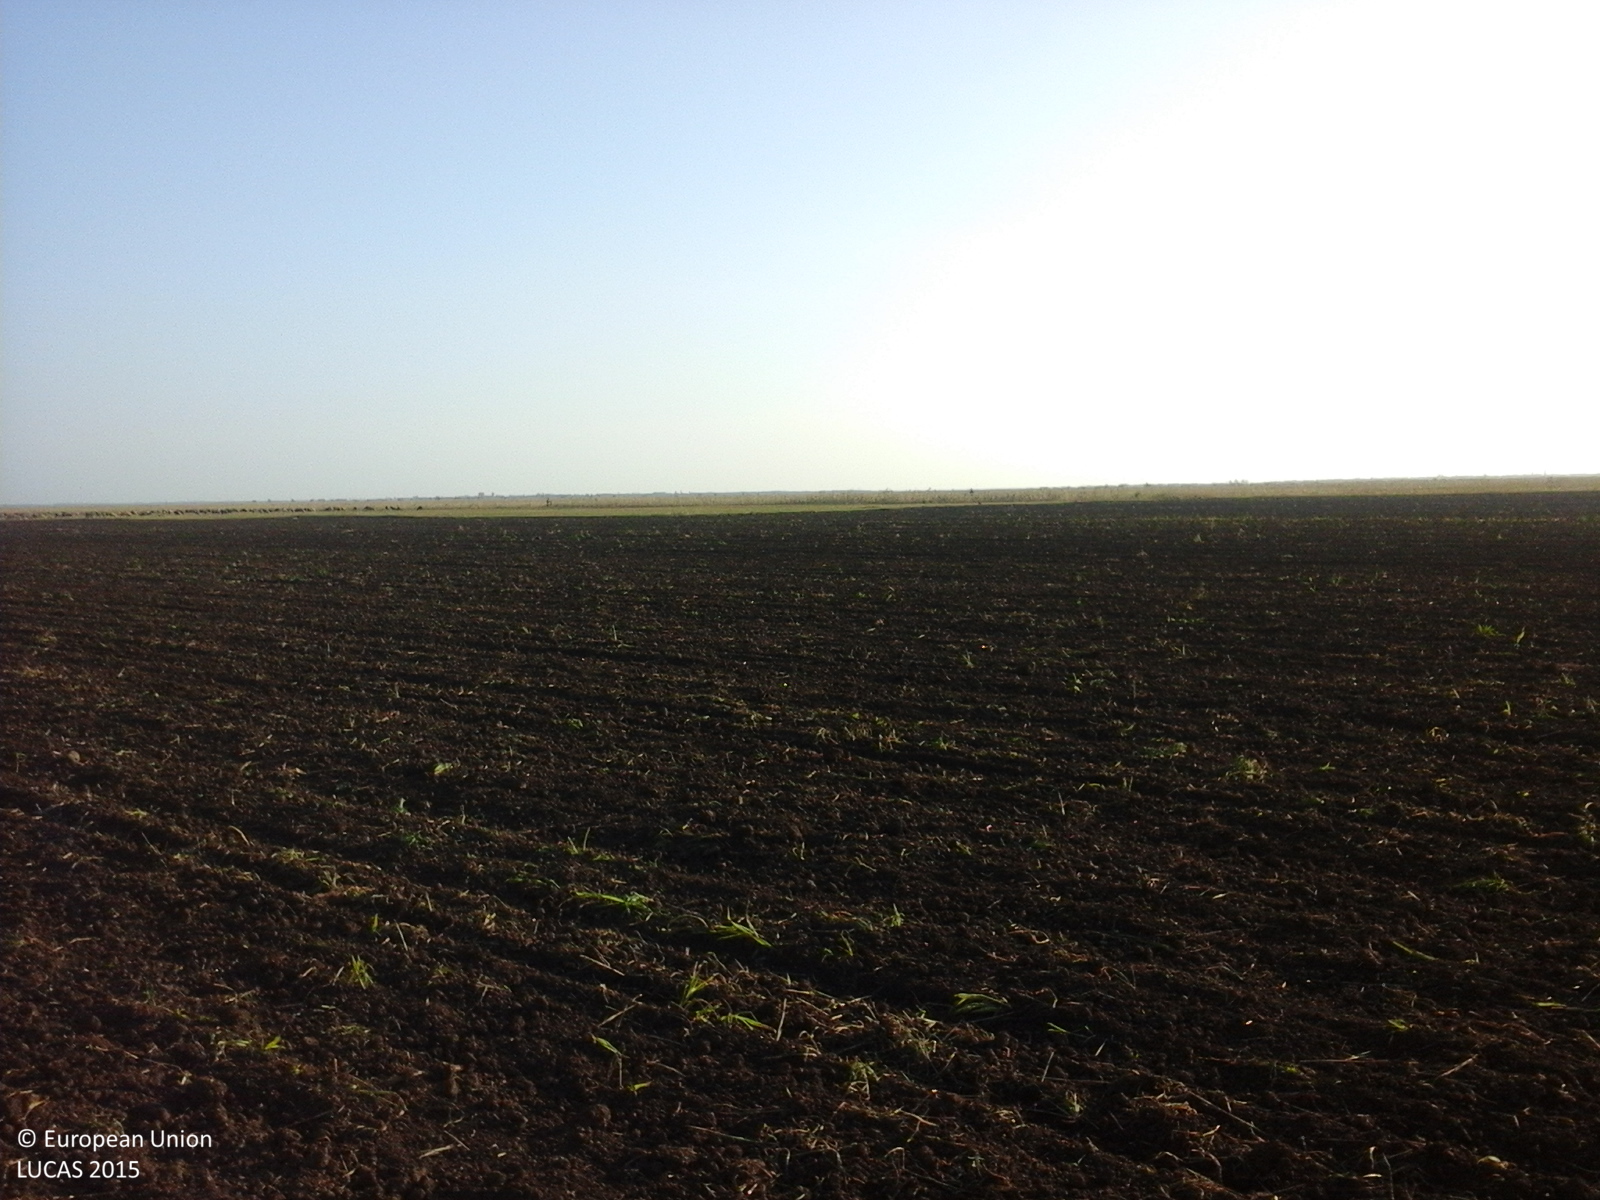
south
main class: Cropland
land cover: Common wheat
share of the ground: < 10 %
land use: Agriculture (excluding fallow land and kitchen gardens)
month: October
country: RO
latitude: 45.1709
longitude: 26.9423
